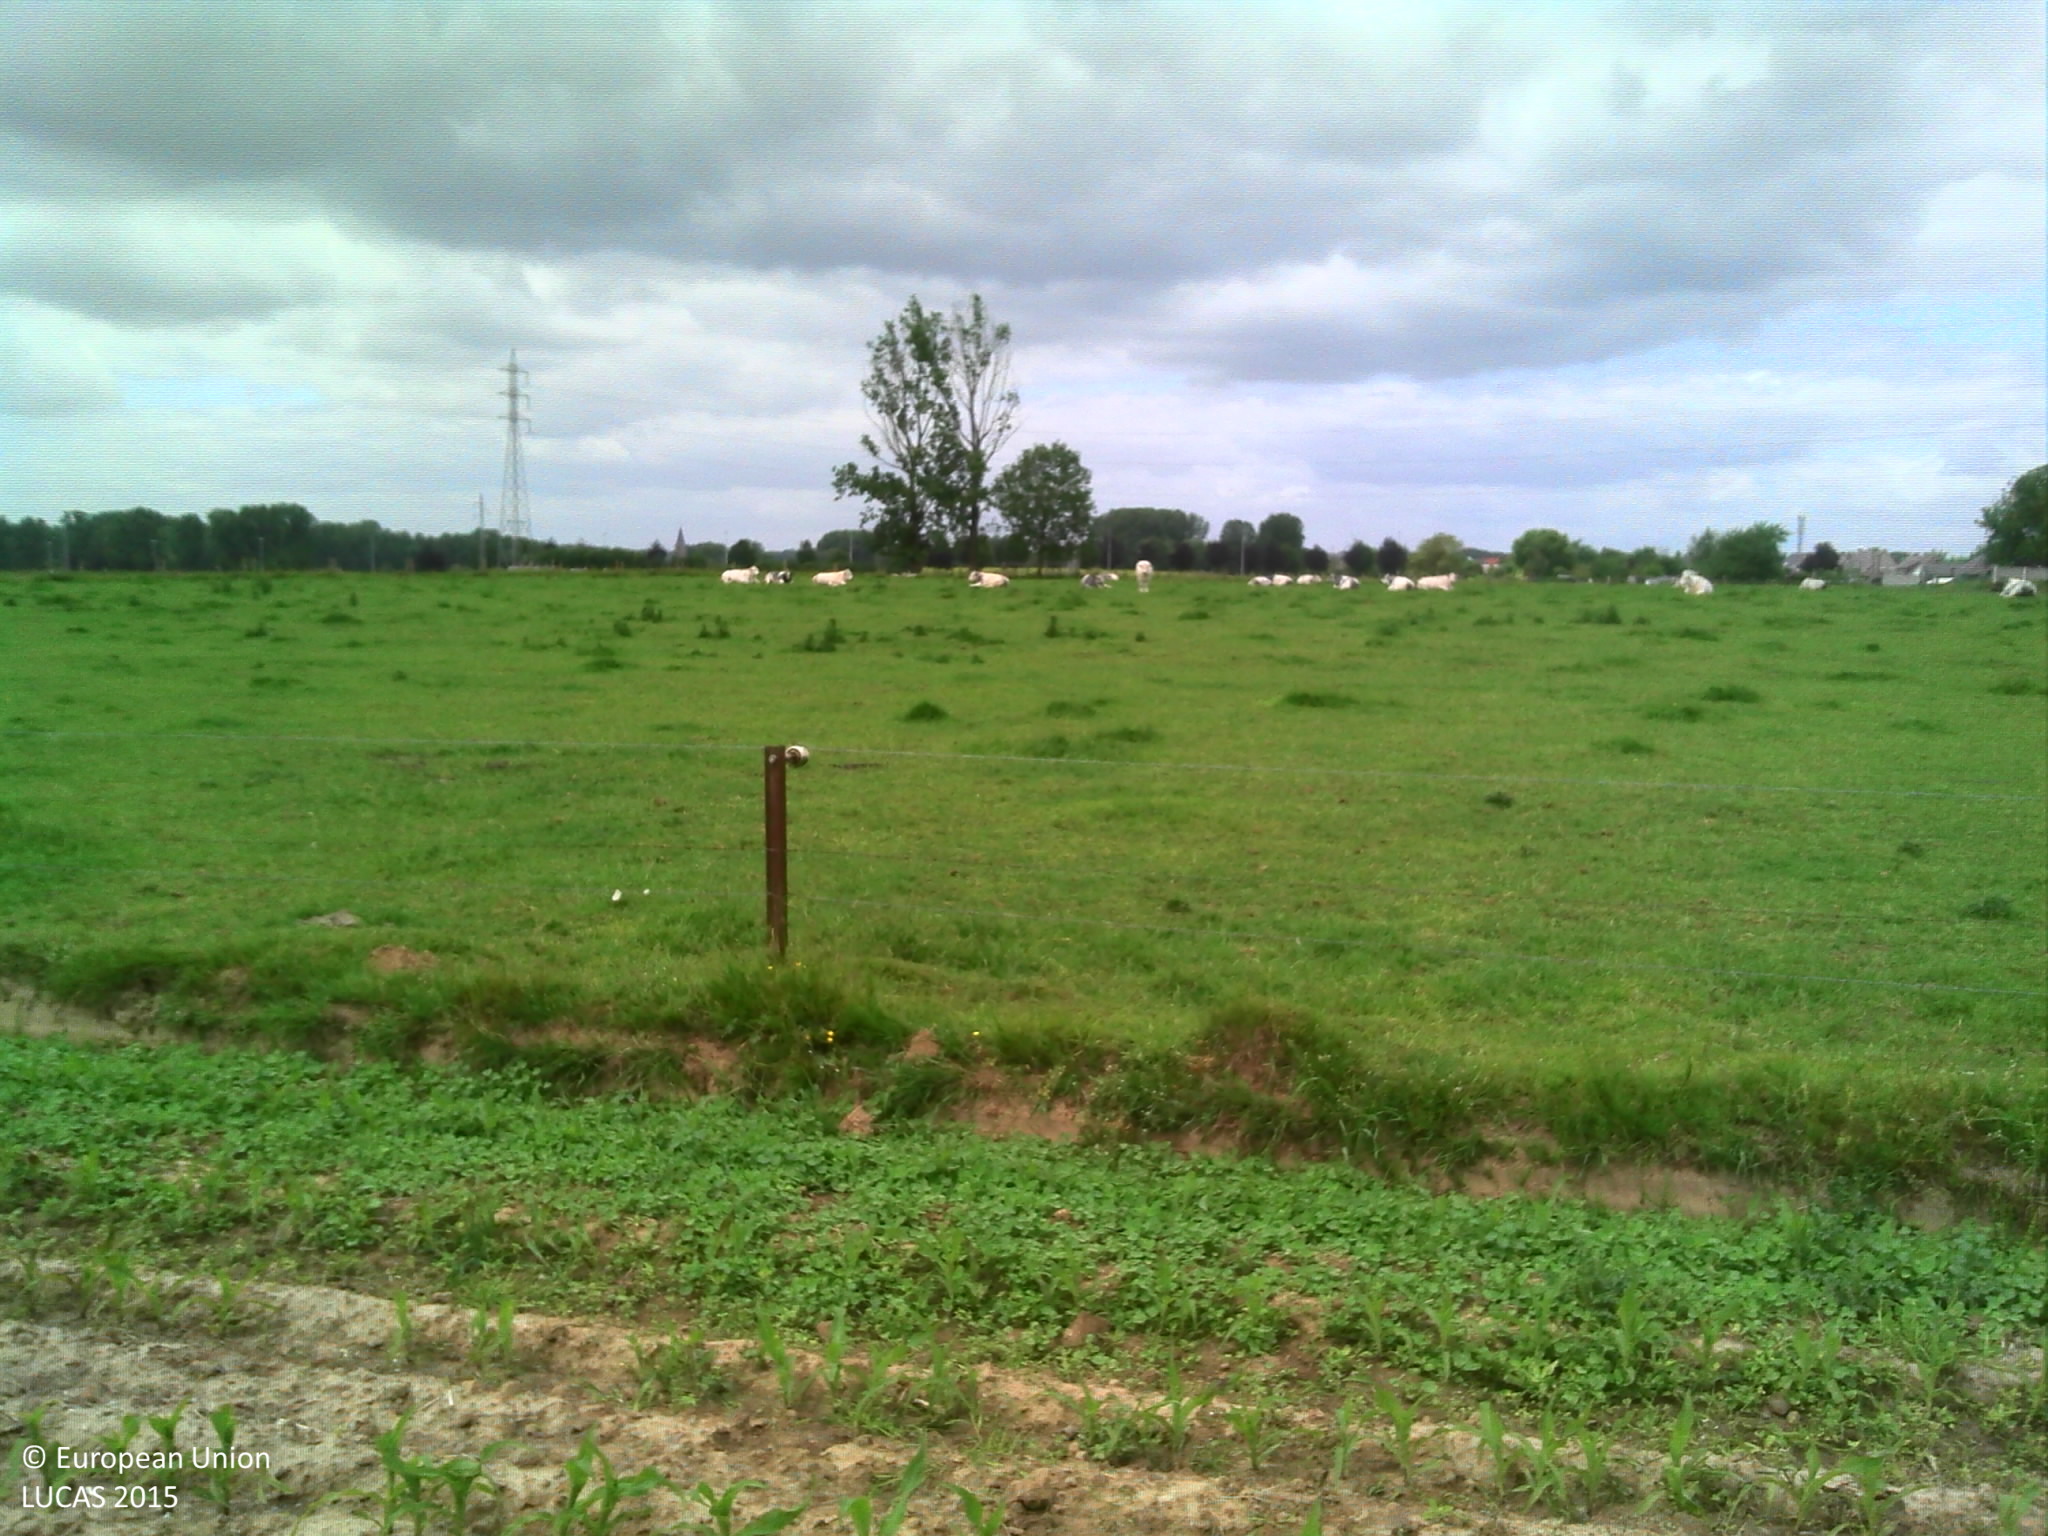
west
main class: Cropland
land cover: Maize
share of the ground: 25 - 50 %
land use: Agriculture (excluding fallow land and kitchen gardens)
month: June
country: BE
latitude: 50.8757
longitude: 4.0396
